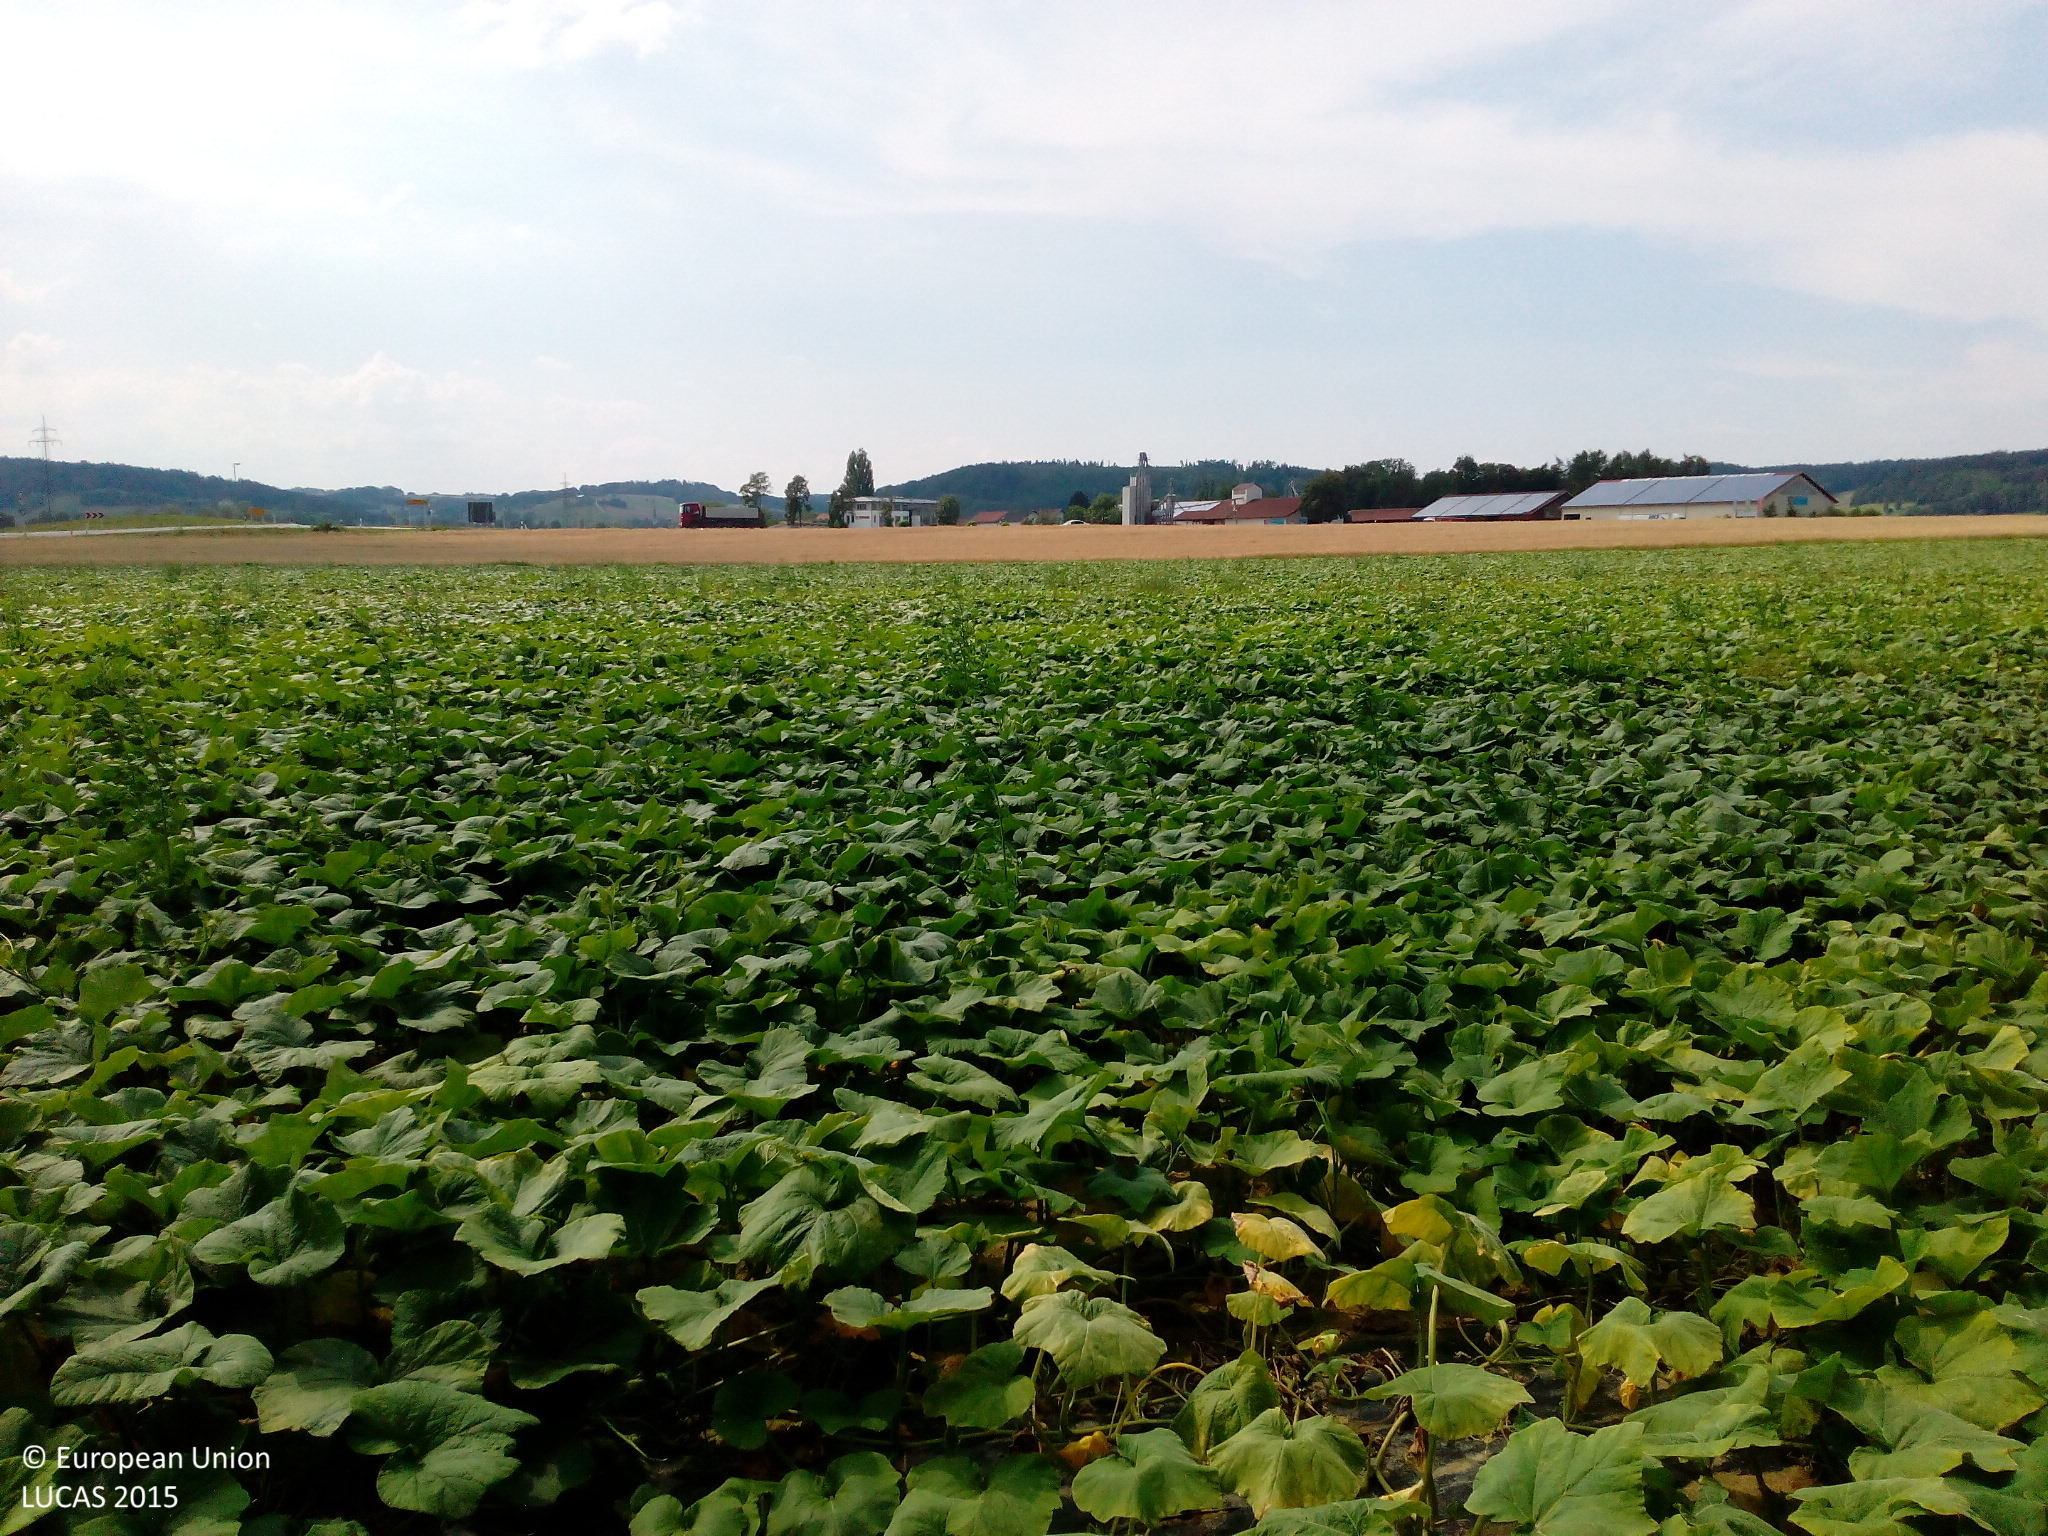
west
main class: Cropland
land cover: Other fresh vegetables
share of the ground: > 75 %
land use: Agriculture (excluding fallow land and kitchen gardens)
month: August
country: DE
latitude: 48.1979
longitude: 12.3803
